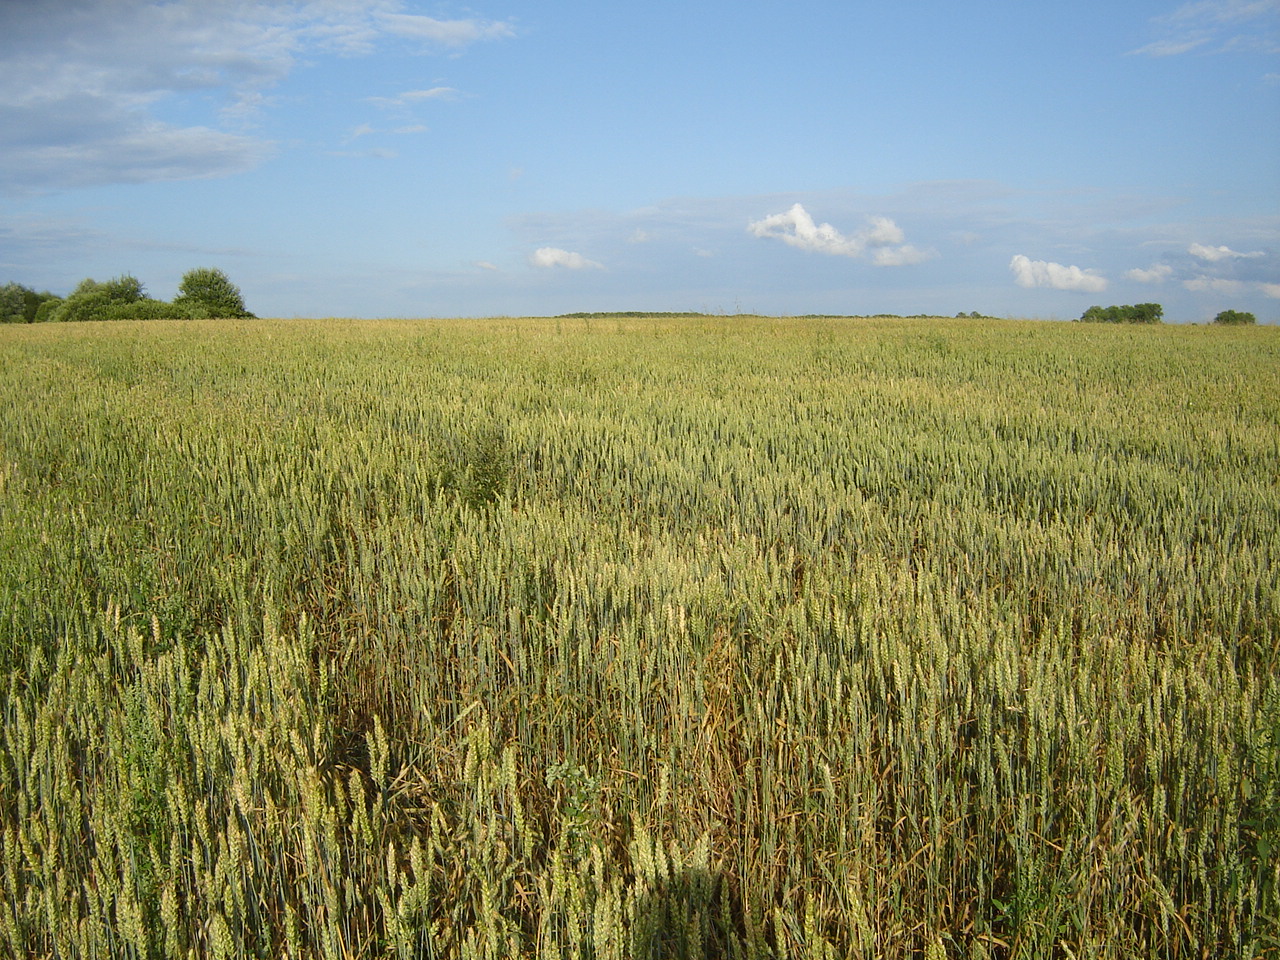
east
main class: Cropland
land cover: Common wheat
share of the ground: > 75 %
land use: Agriculture (excluding fallow land and kitchen gardens)
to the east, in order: Common wheat
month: July
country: LT
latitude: 55.3323
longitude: 24.7186
